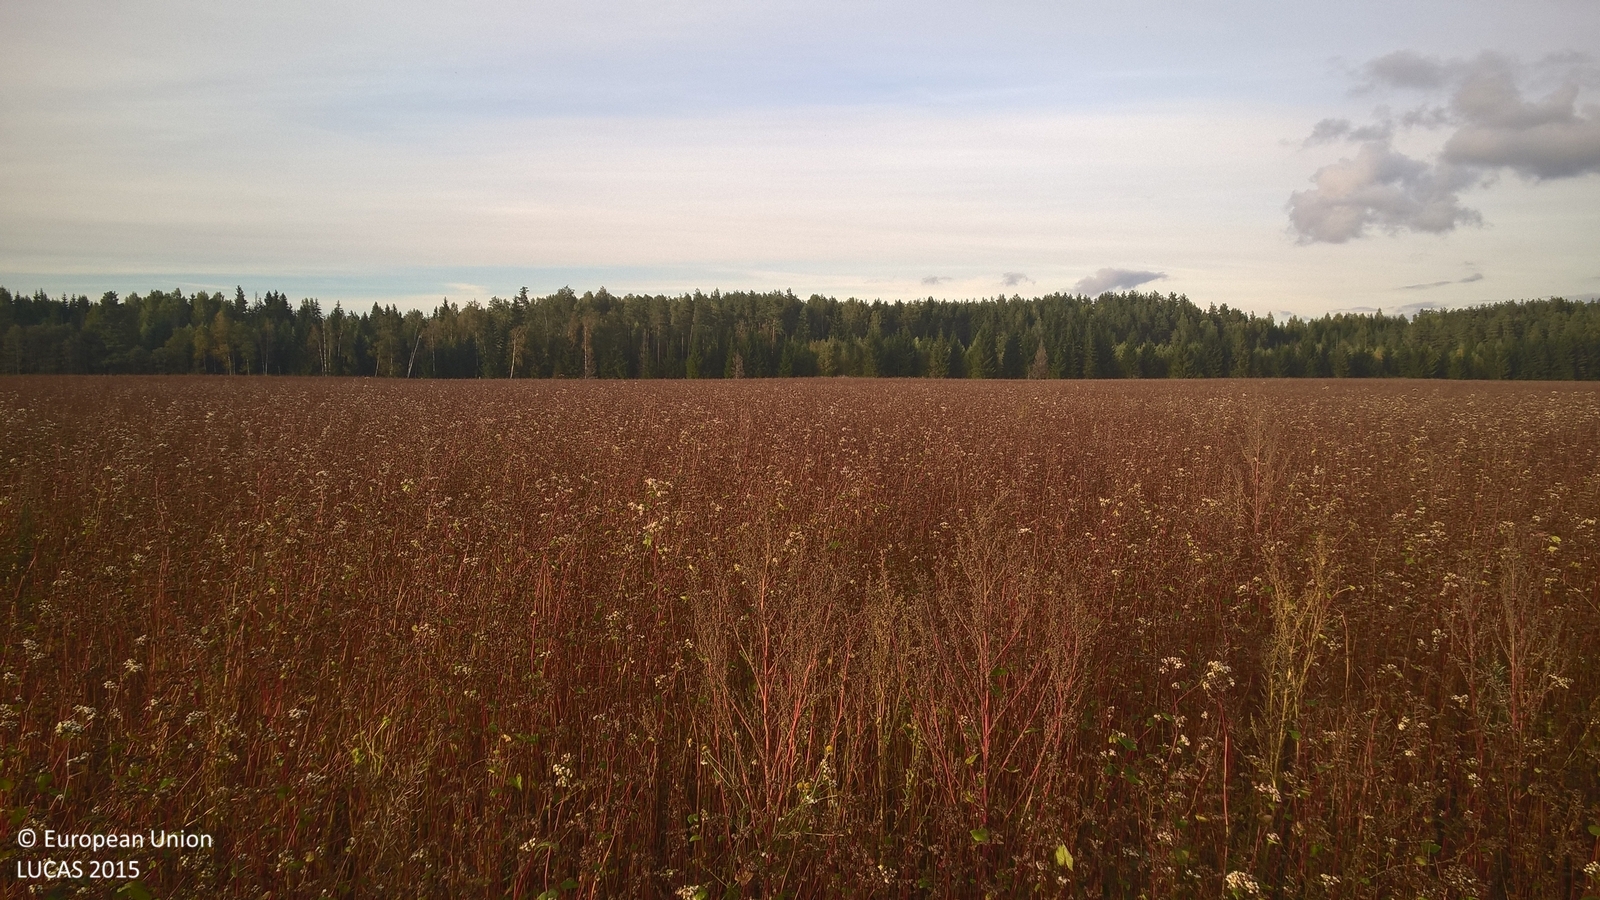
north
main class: Cropland
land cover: Other cereals
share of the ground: > 75 %
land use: Agriculture (excluding fallow land and kitchen gardens)
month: September
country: LV
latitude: 57.8046
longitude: 25.6836
